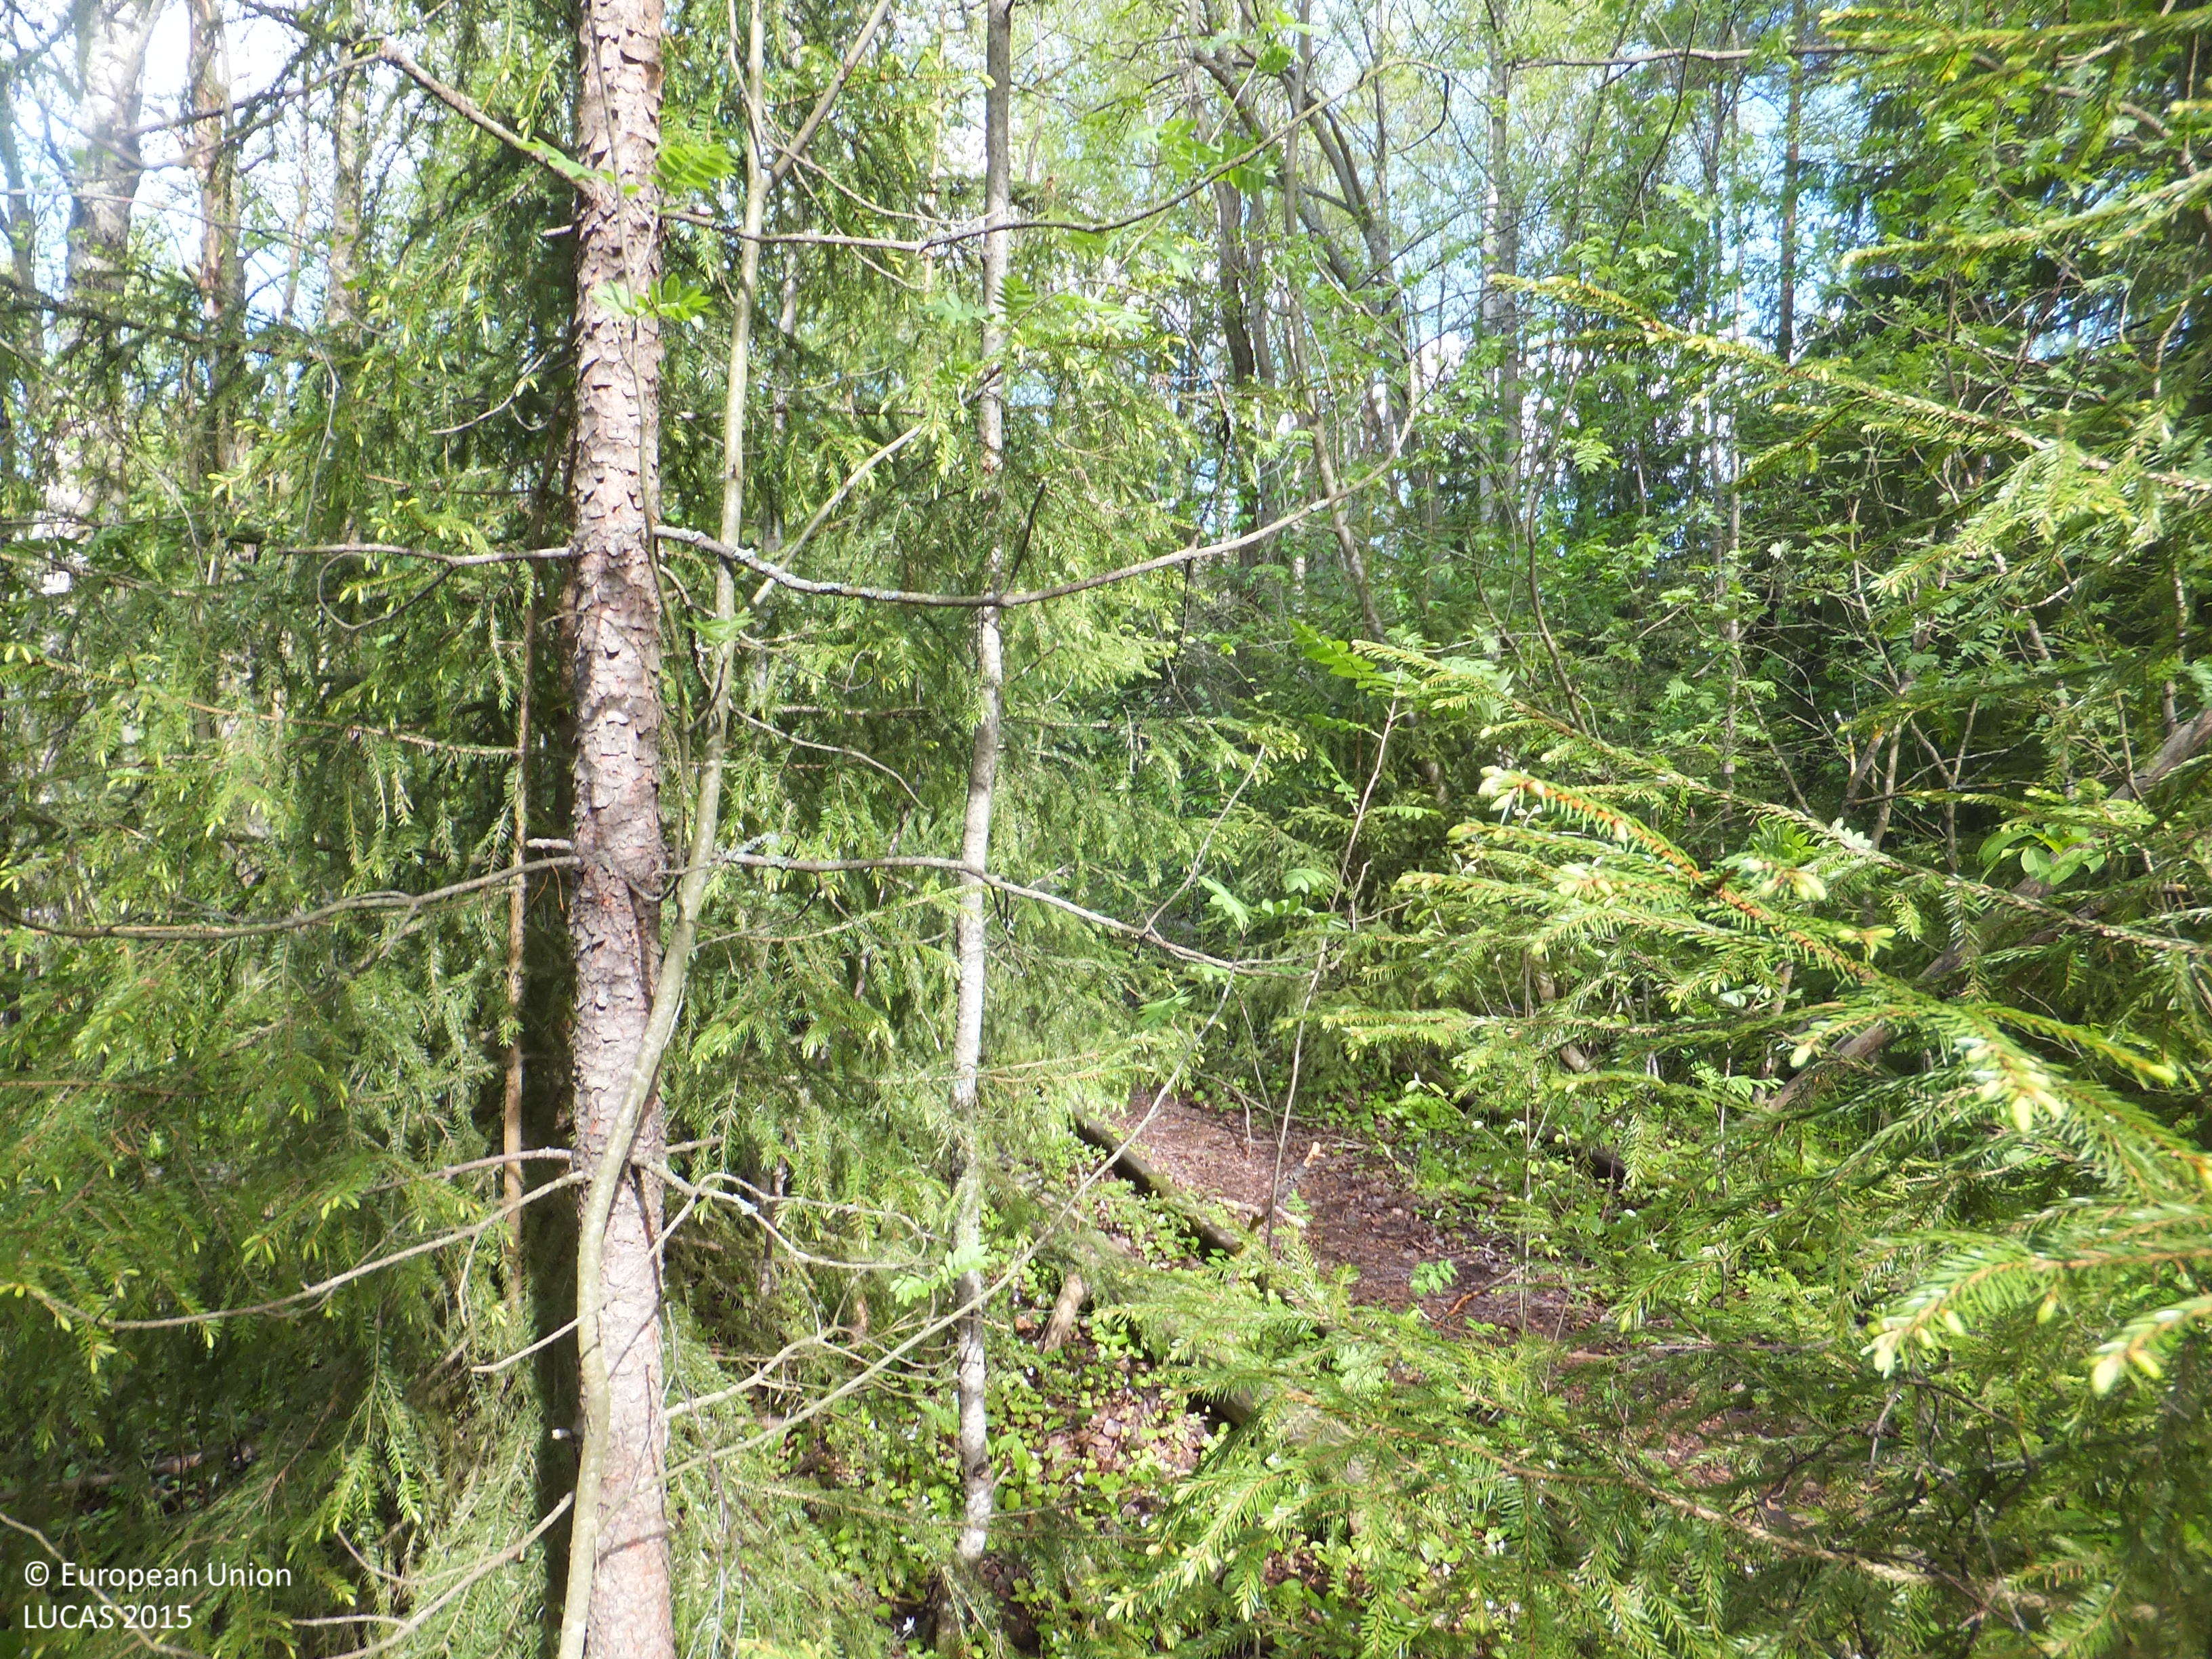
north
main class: Woodland
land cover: Other mixed woodland
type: boreal forest
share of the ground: > 75 %
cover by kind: broadleaved forest trees 70 %, coniferous forest trees 30 %
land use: Semi-natural and natural areas not in use
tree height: > 5 m
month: May
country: FI
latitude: 63.6643
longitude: 22.7165
